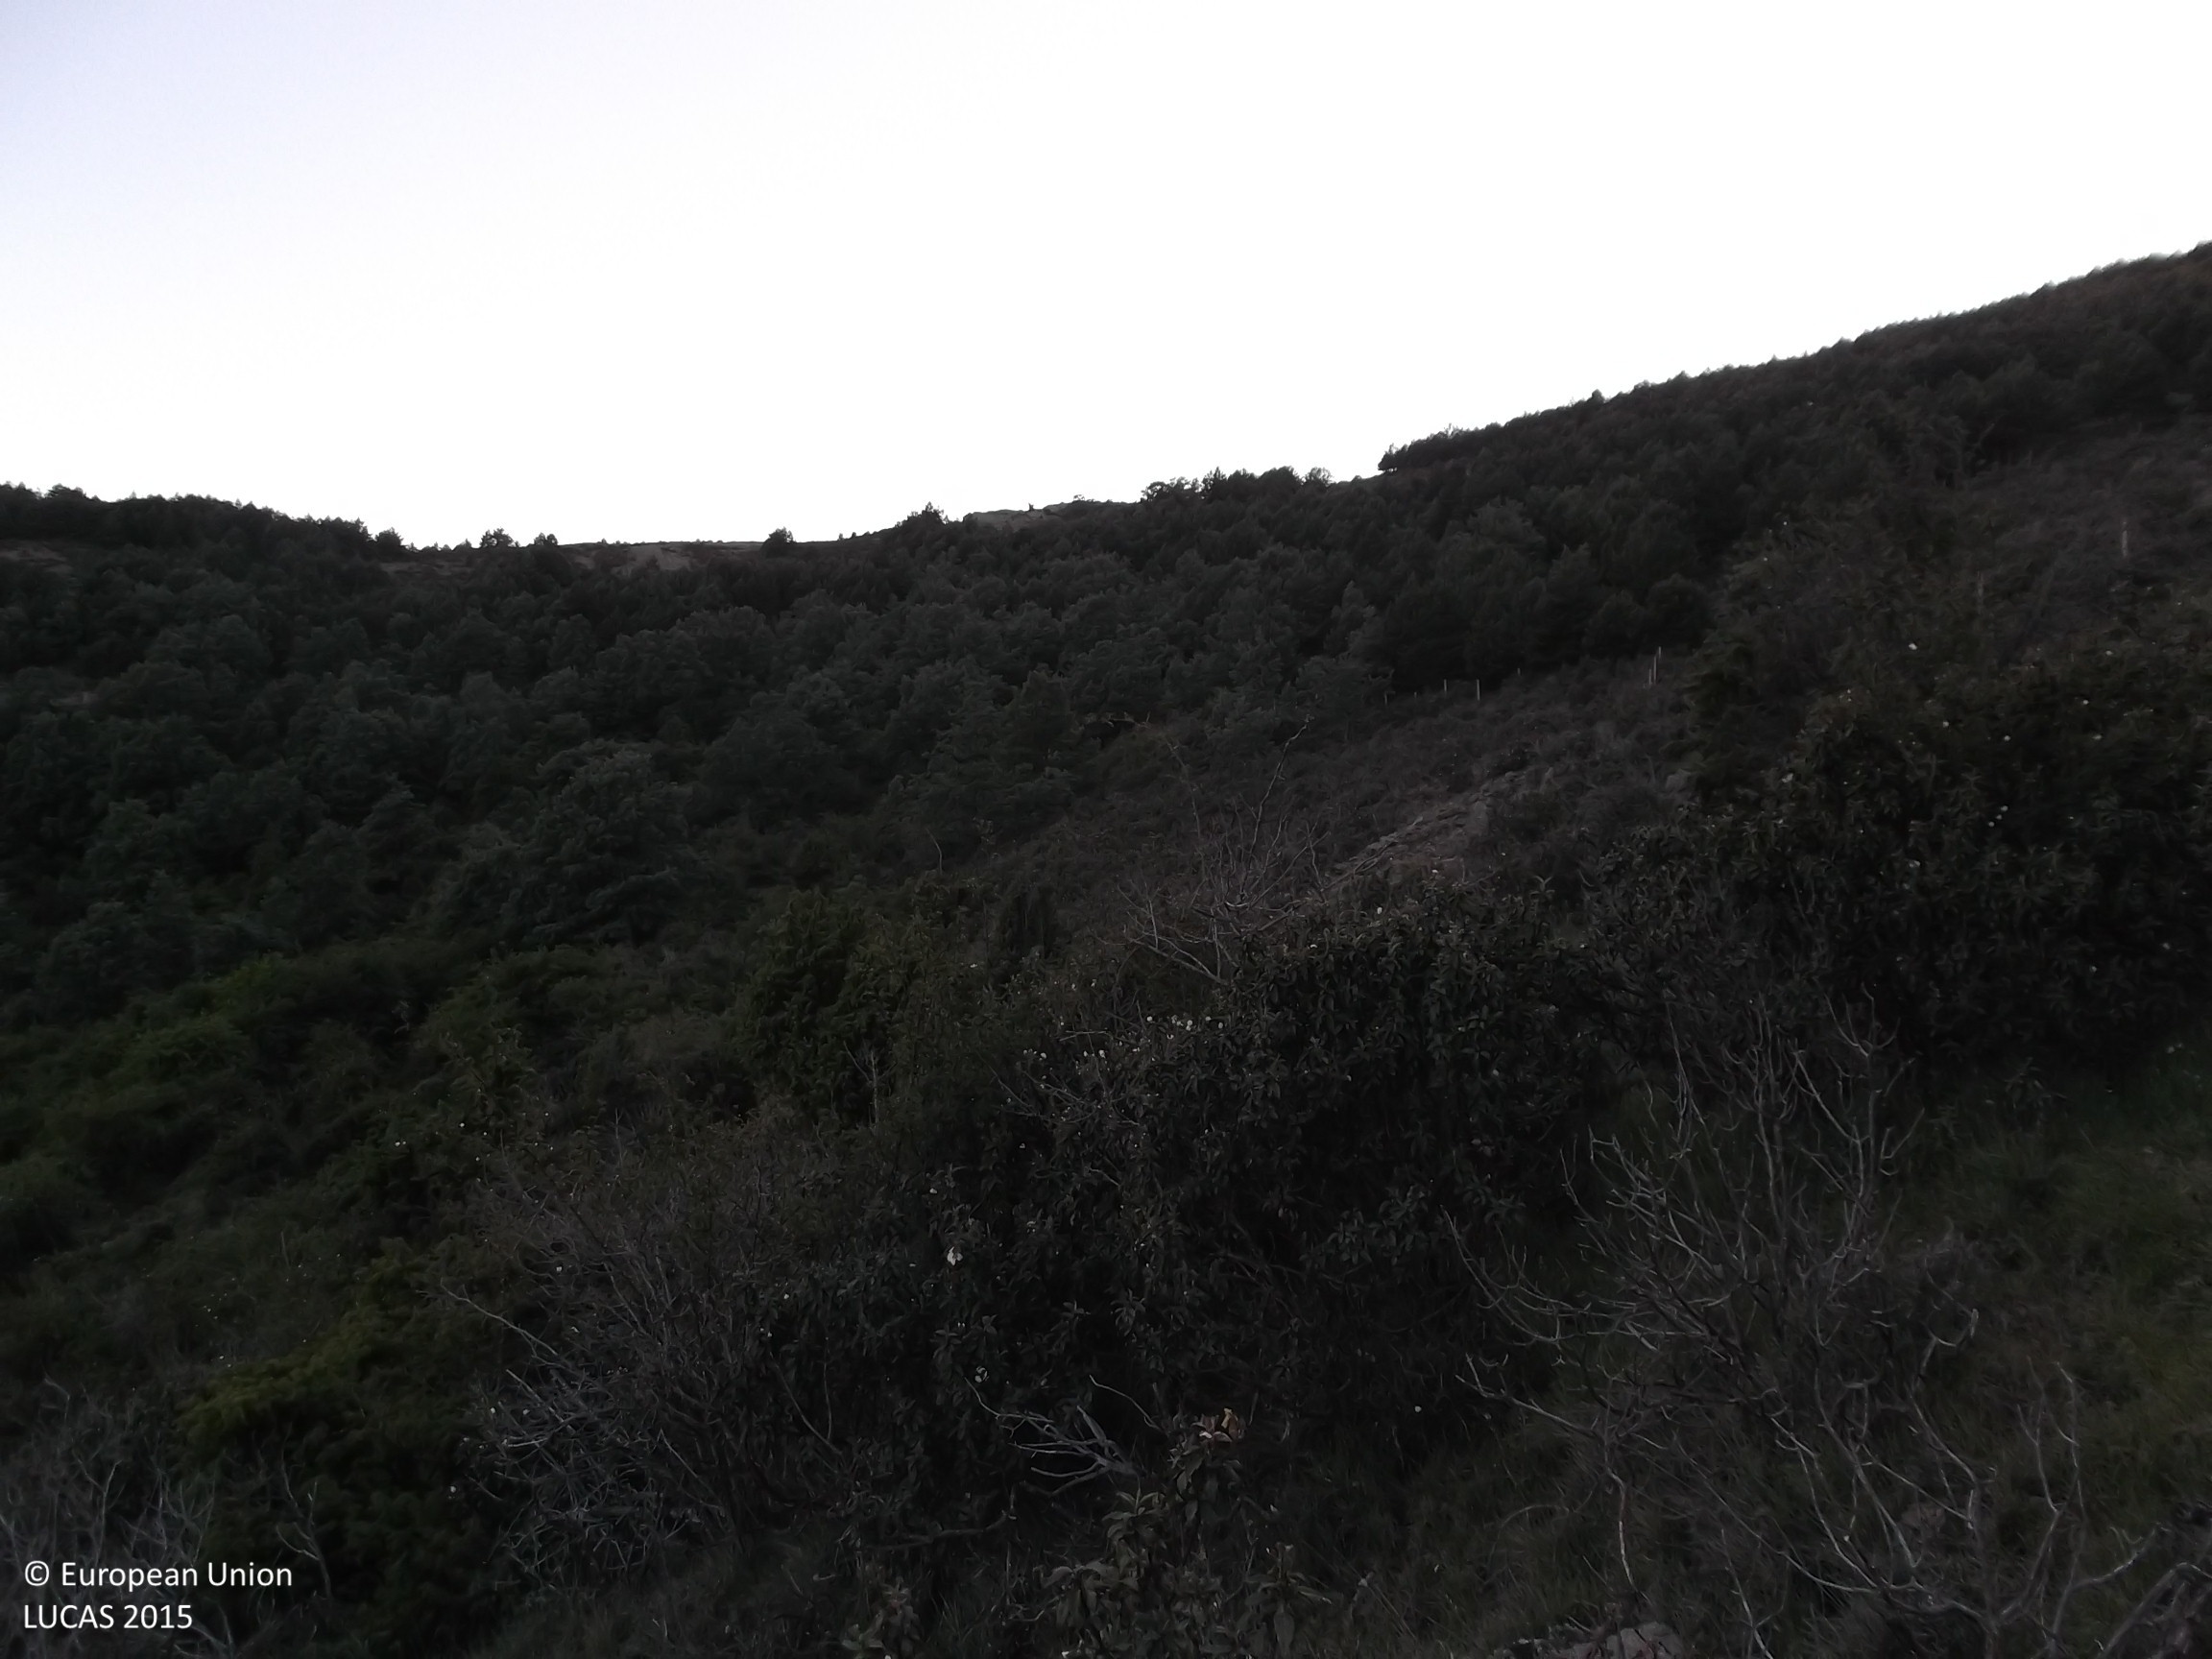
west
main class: Shrubland
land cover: Shrubland with sparse tree cover
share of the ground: 50 - 75 %
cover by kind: shrubs 60 %, herbaceous plants 20 %, unconsolidated bare surface 15 %, broadleaved forest trees 5 %
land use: Semi-natural and natural areas not in use
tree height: < 5 m
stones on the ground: > 50 %
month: June
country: ES
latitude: 42.1360
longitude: -2.3201
